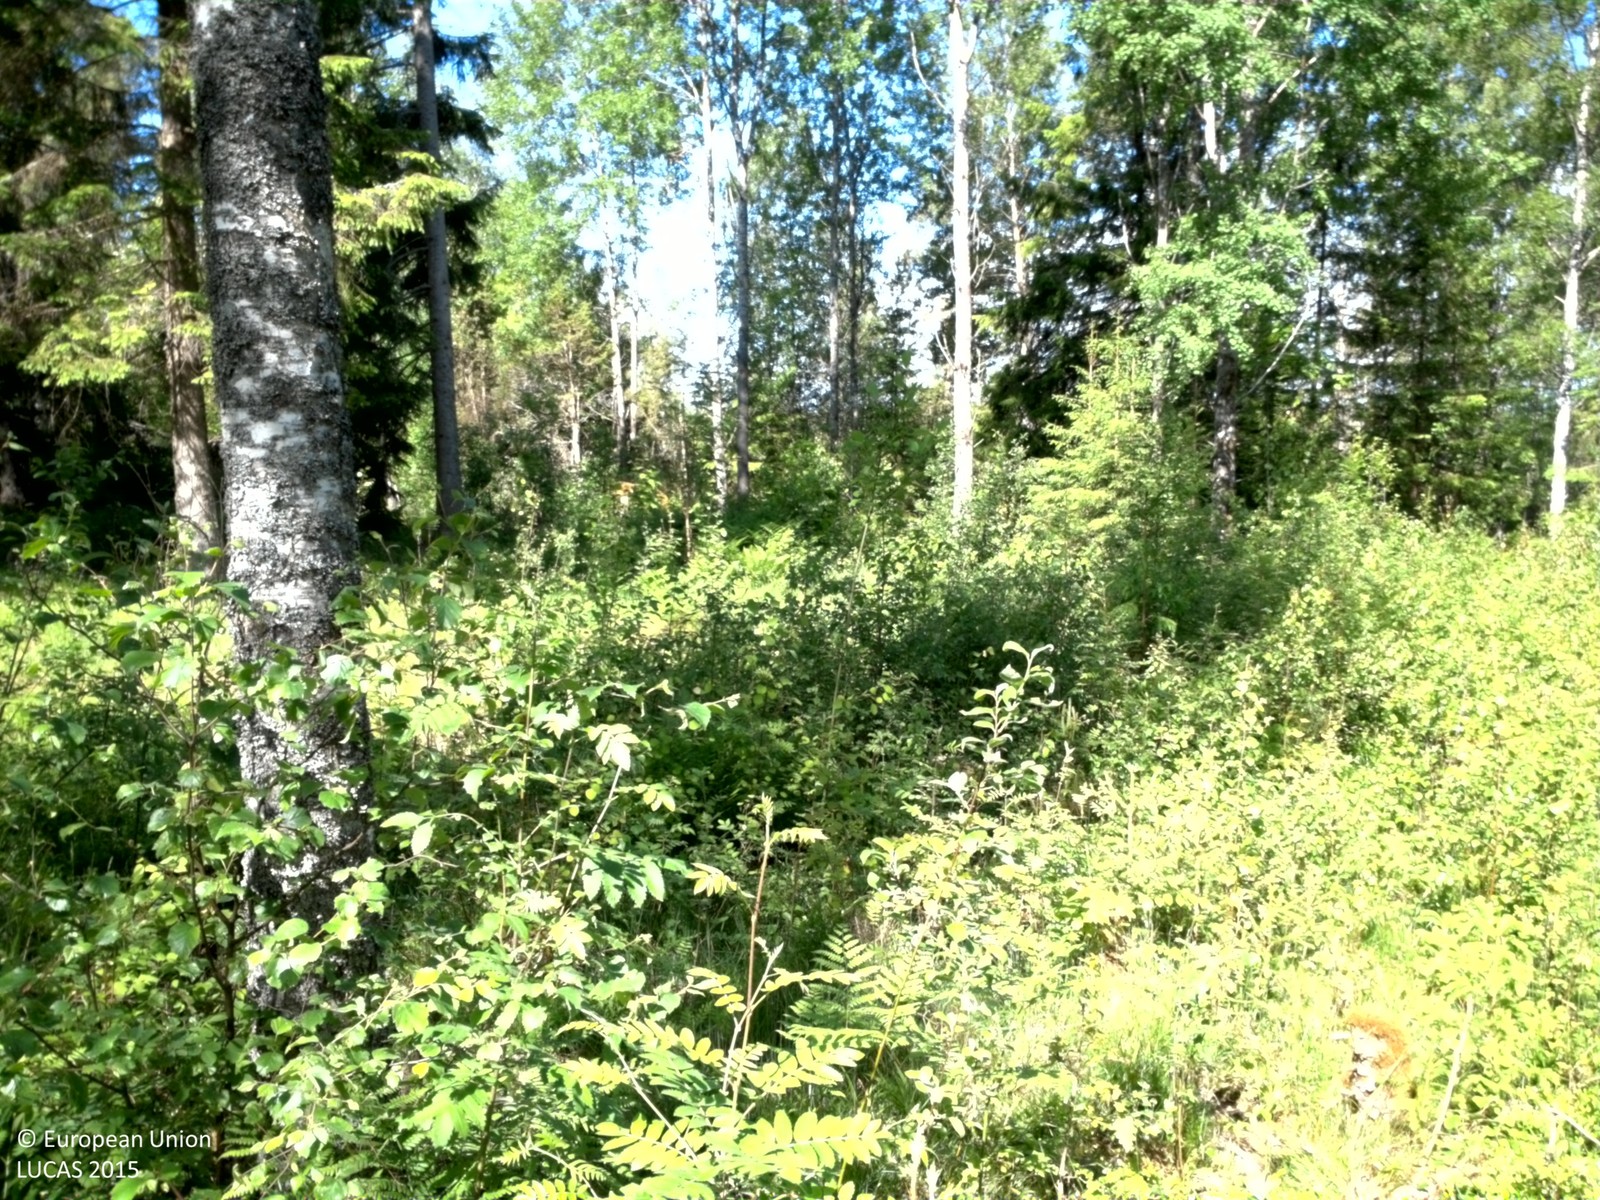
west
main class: Woodland
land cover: Broadleaved woodland
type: boreal forest
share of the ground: 25 - 50 %
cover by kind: herbaceous plants 50 %, broadleaved forest trees 25 %, shrubs 20 %, coniferous forest trees 5 %
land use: Forestry
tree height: > 5 m
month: June
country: SE
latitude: 58.6176
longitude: 14.3491
